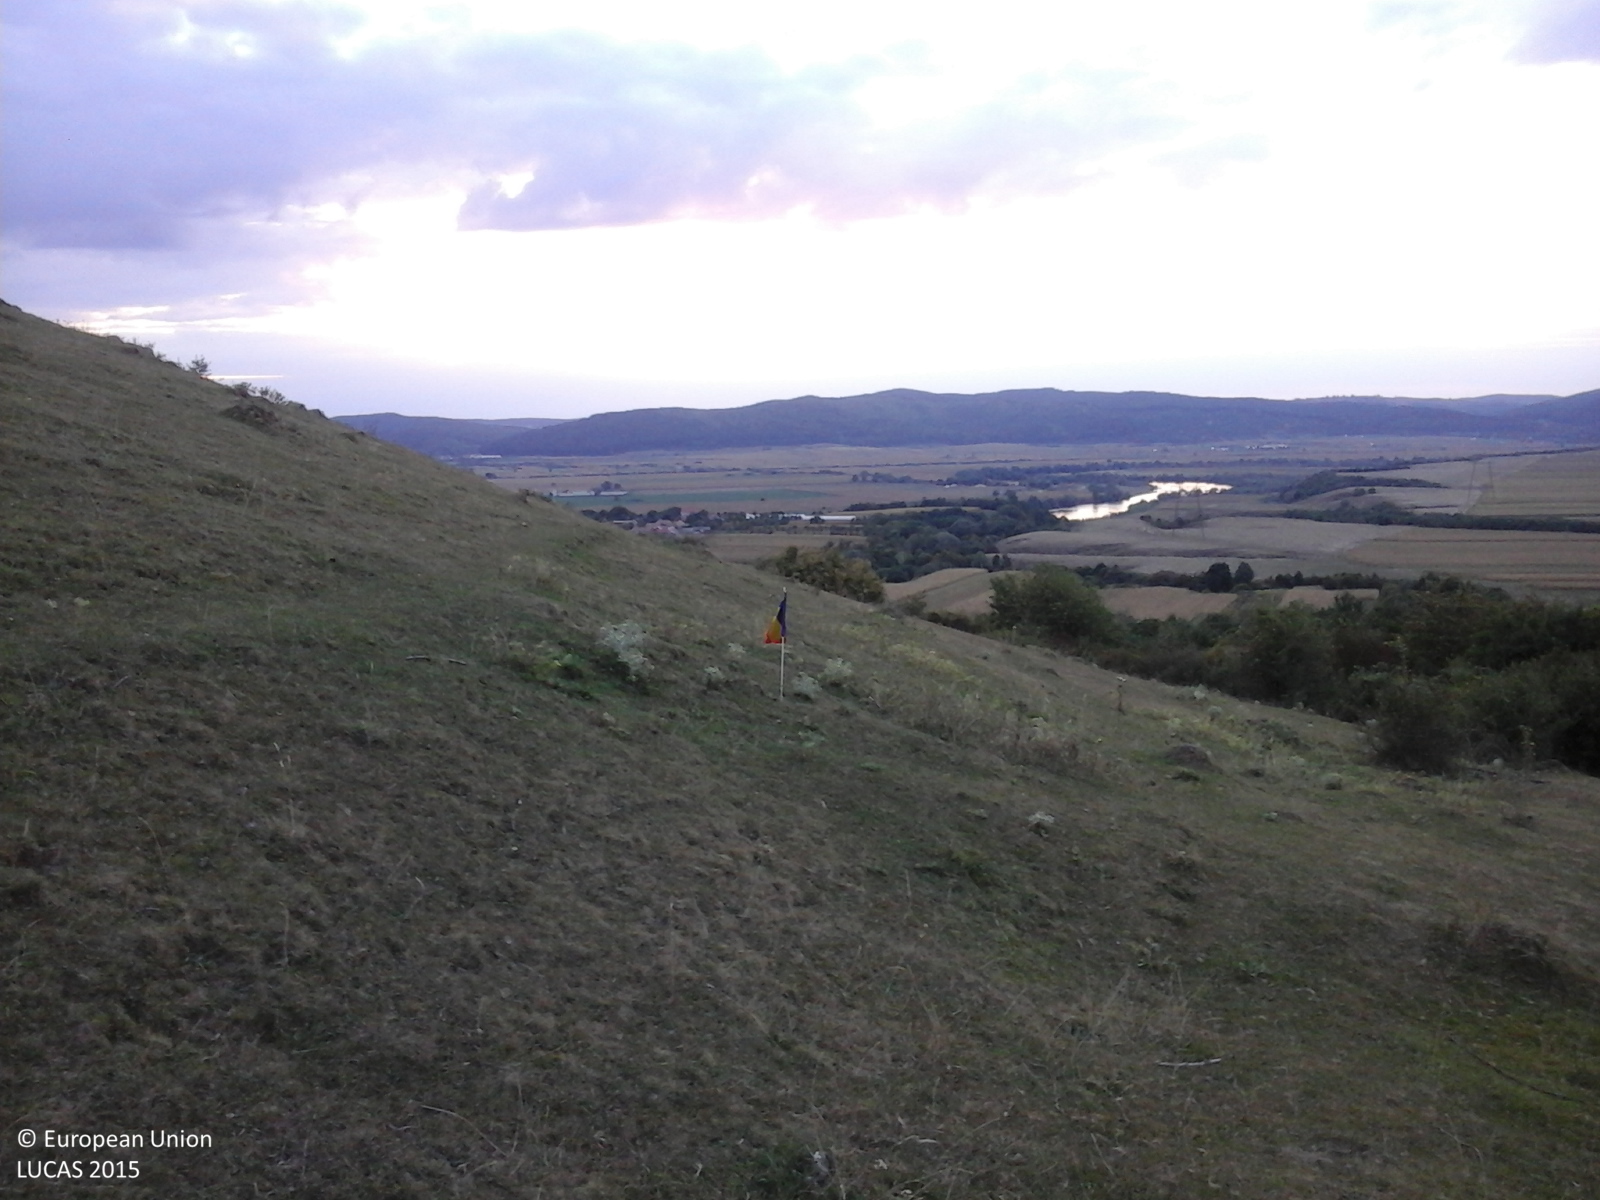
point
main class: Grassland
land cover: Grassland without tree/shrub cover
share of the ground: > 75 %
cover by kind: herbaceous plants 100 %
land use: Agriculture (excluding fallow land and kitchen gardens)
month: September
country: RO
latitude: 47.2852
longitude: 23.3038
